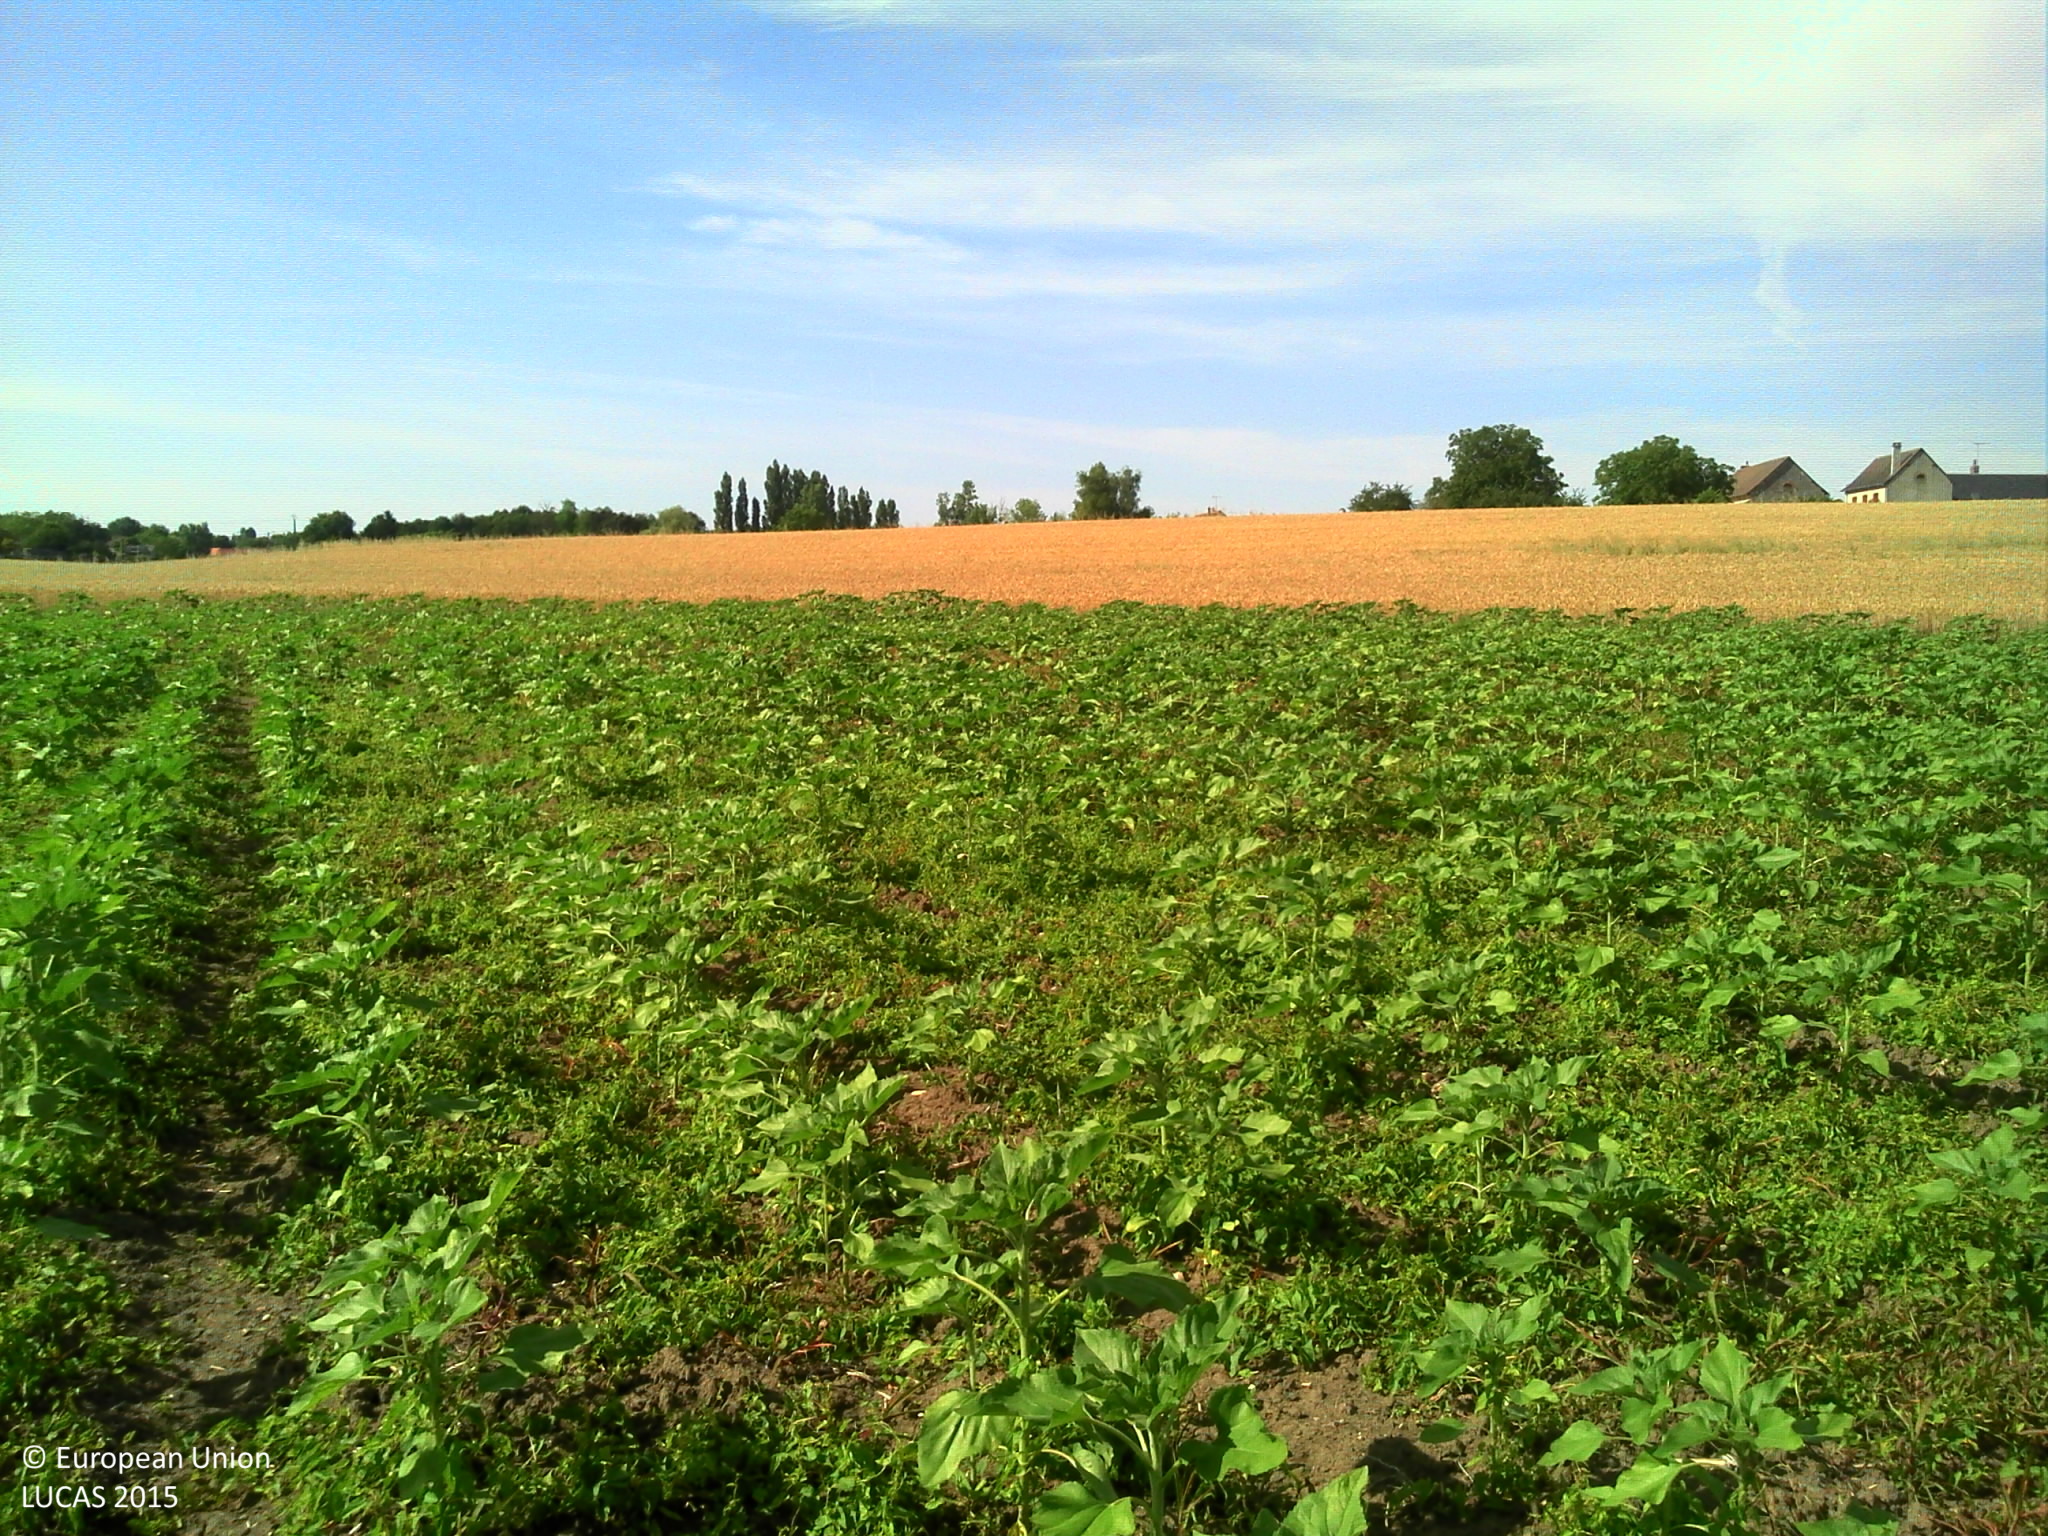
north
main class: Cropland
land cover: Sunflower
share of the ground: 50 - 75 %
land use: Agriculture (excluding fallow land and kitchen gardens)
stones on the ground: < 10 %
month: June
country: FR
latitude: 46.8140
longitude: 0.4794
